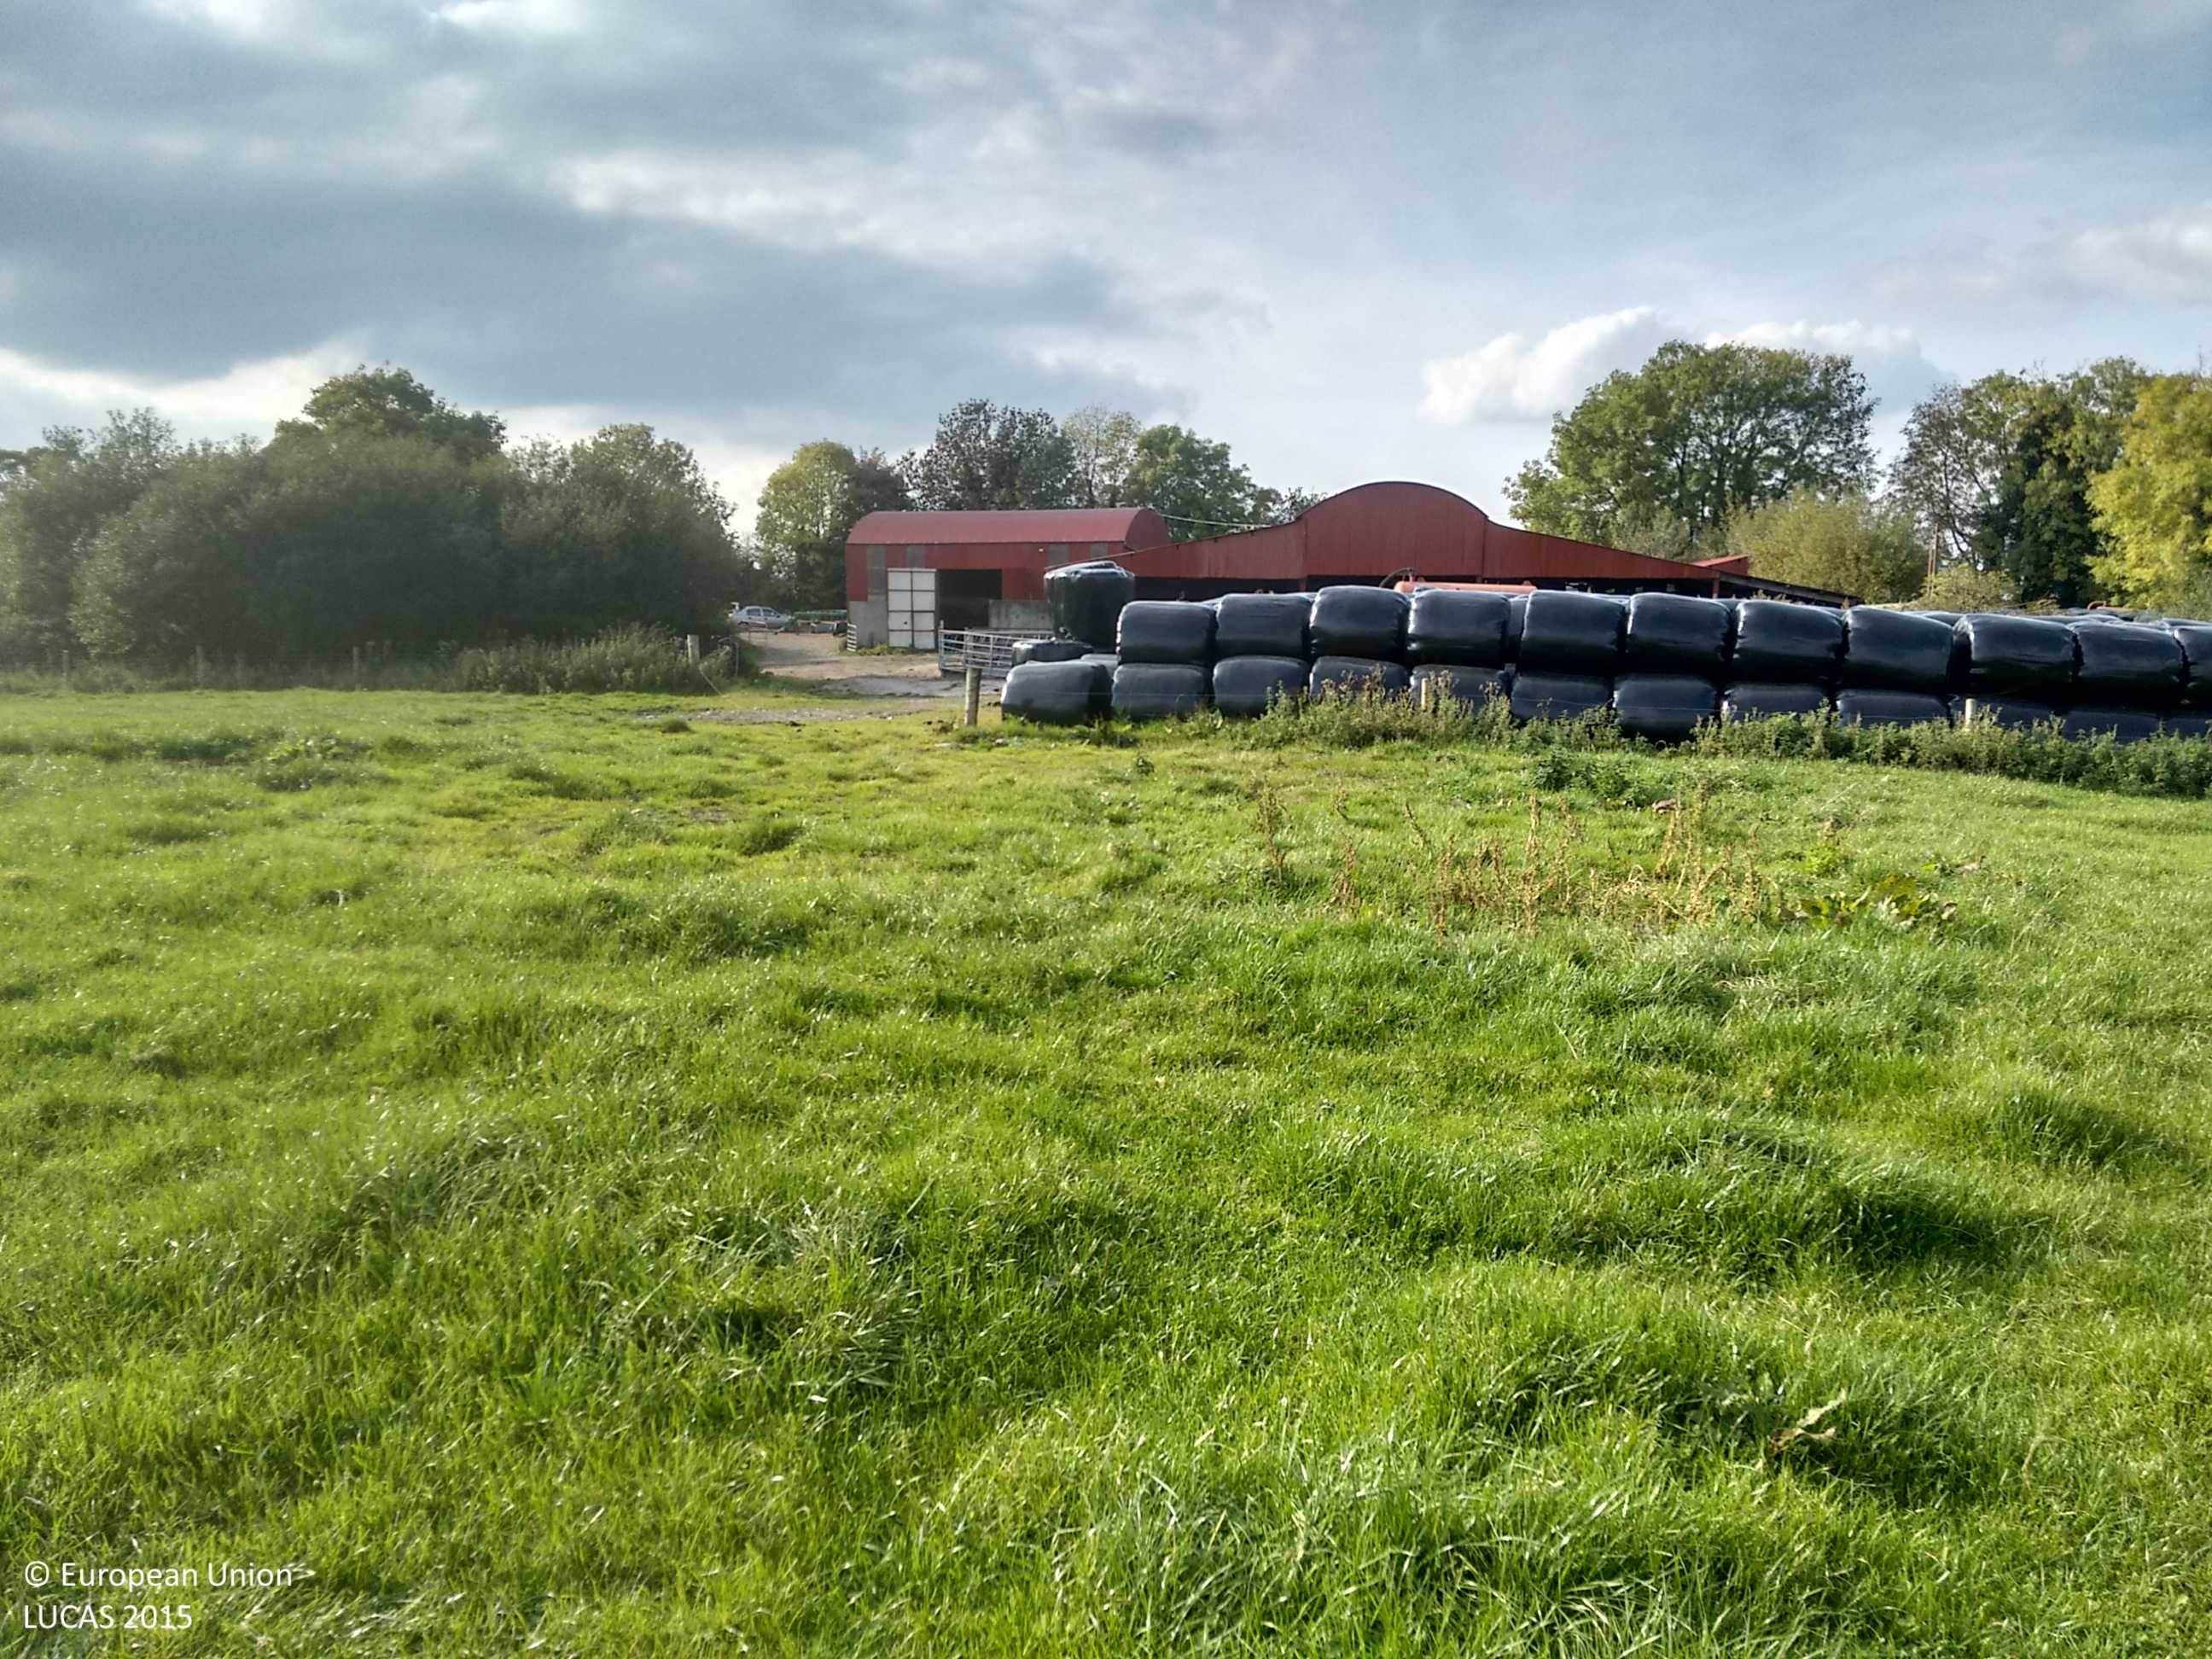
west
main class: Grassland
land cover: Grassland without tree/shrub cover
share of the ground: > 75 %
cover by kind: herbaceous plants 100 %
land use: Agriculture (excluding fallow land and kitchen gardens)
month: October
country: IE
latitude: 52.8690
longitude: -7.6180
